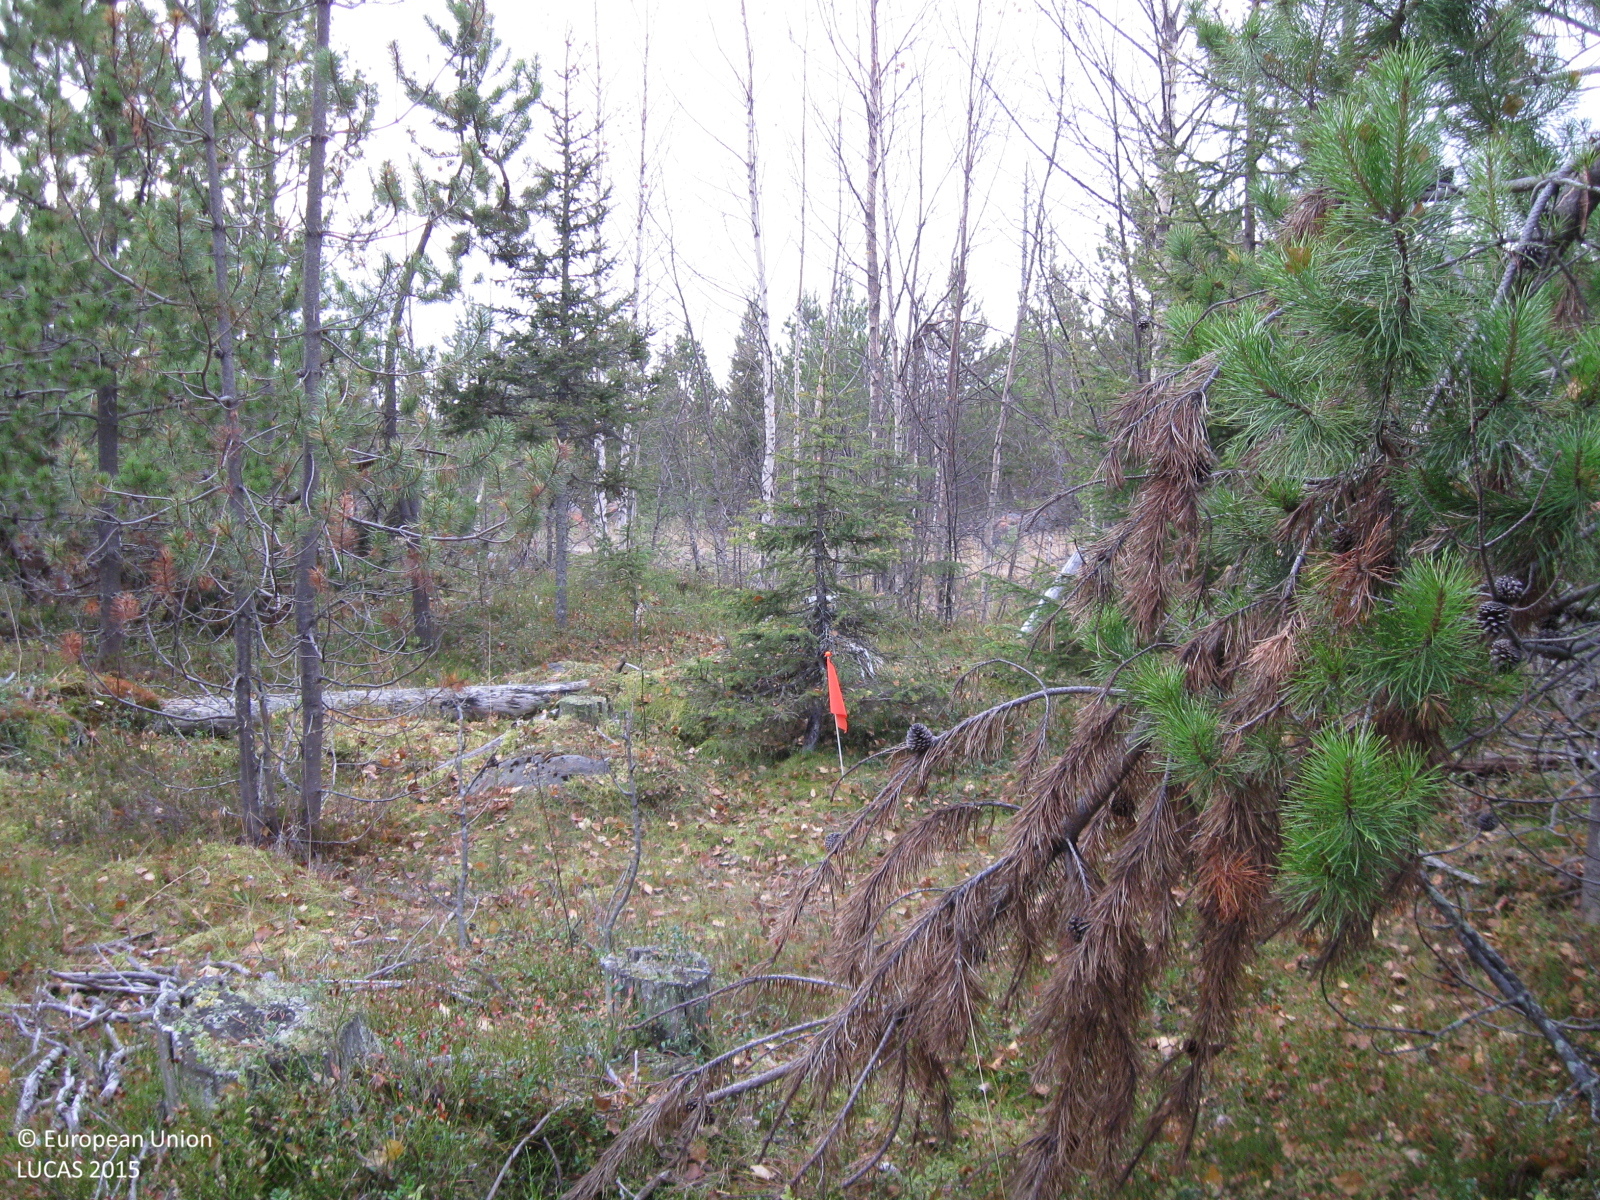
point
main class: Woodland
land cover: Pine dominated coniferous woodland
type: exotic forest
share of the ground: > 75 %
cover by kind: coniferous forest trees 80 %, broadleaved forest trees 5 %, herbaceous plants 5 %, lichens and mosses 5 %, unconsolidated bare surface 5 %
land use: Forestry
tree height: > 5 m
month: October
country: SE
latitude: 66.1070
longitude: 22.2094
